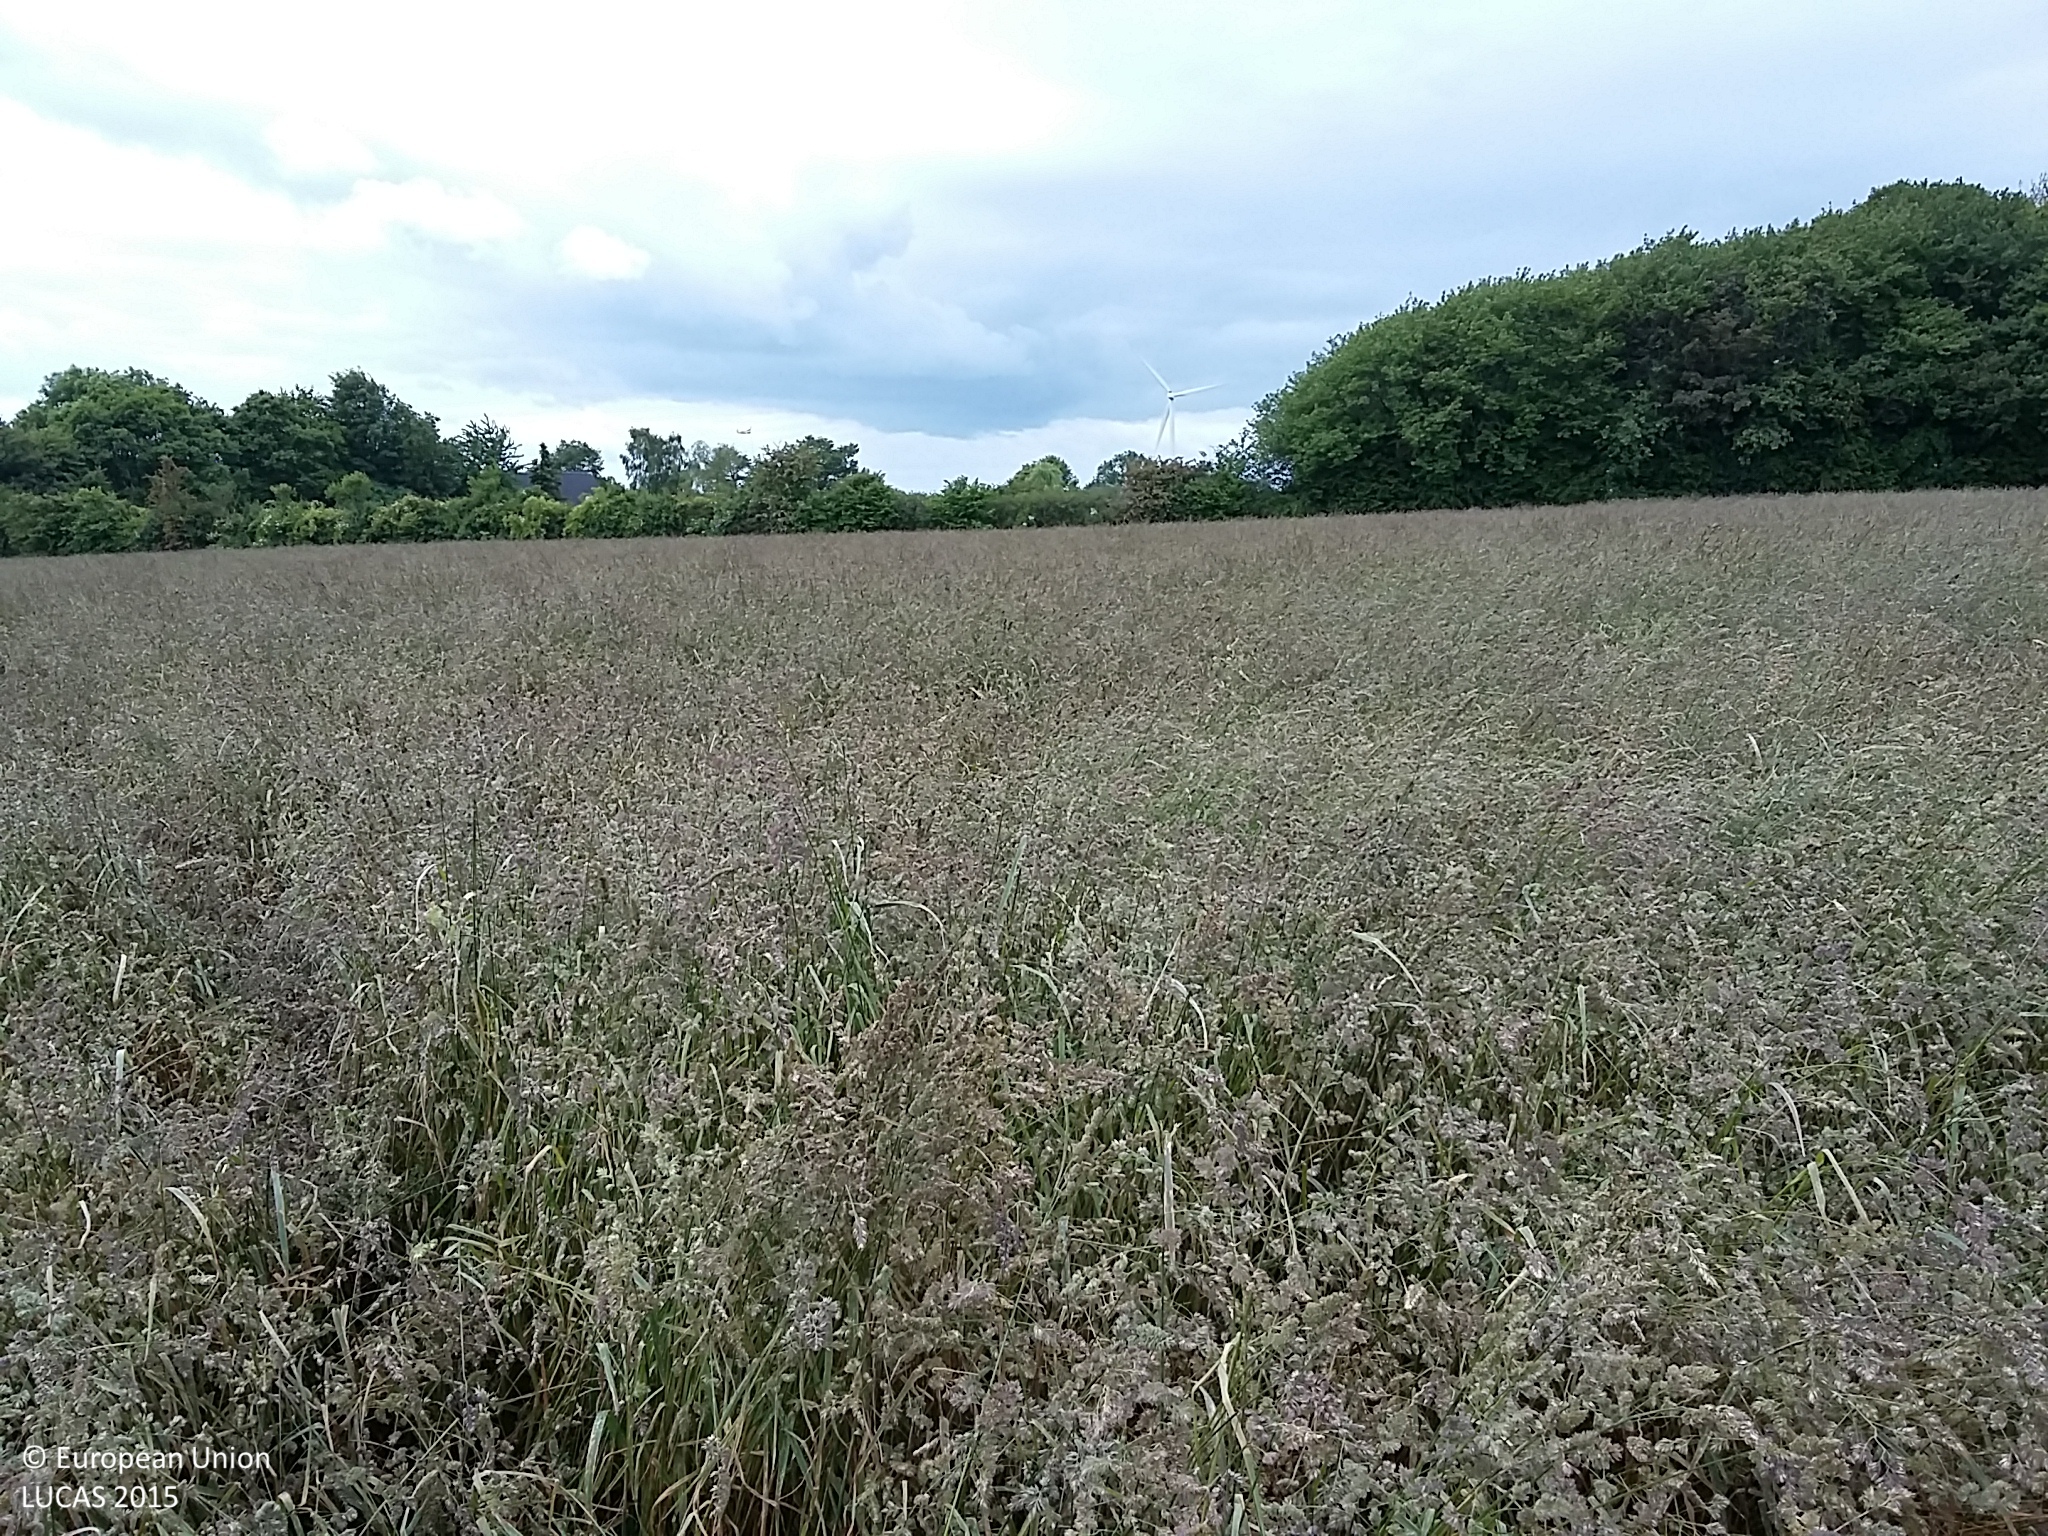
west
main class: Cropland
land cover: Temporary grasslands
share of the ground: > 75 %
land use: Agriculture (excluding fallow land and kitchen gardens)
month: June
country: DK
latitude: 54.9093
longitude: 10.7637
